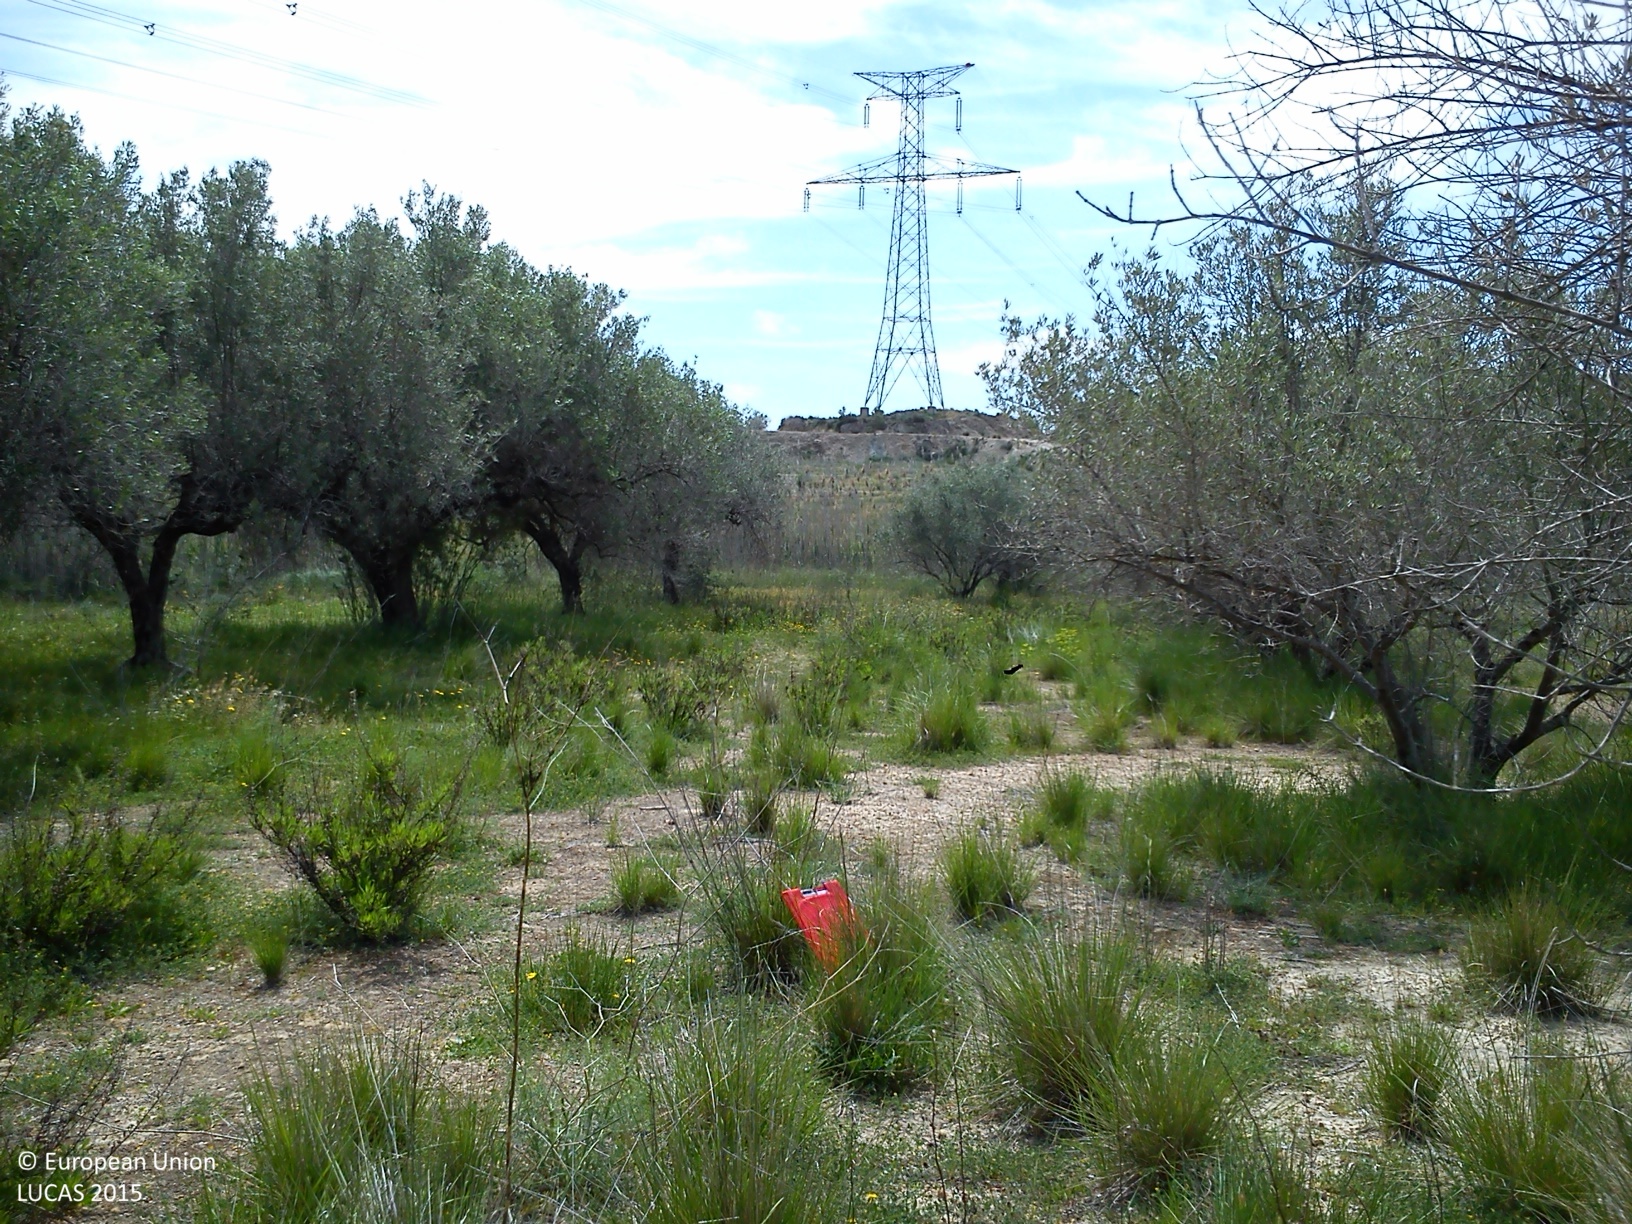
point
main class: Cropland
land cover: Olive groves
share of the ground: 25 - 50 %
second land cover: Spontaneously vegetated surfaces
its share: > 75 %
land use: Agriculture (excluding fallow land and kitchen gardens)
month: April
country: ES
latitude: 39.3229
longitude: -0.6337
